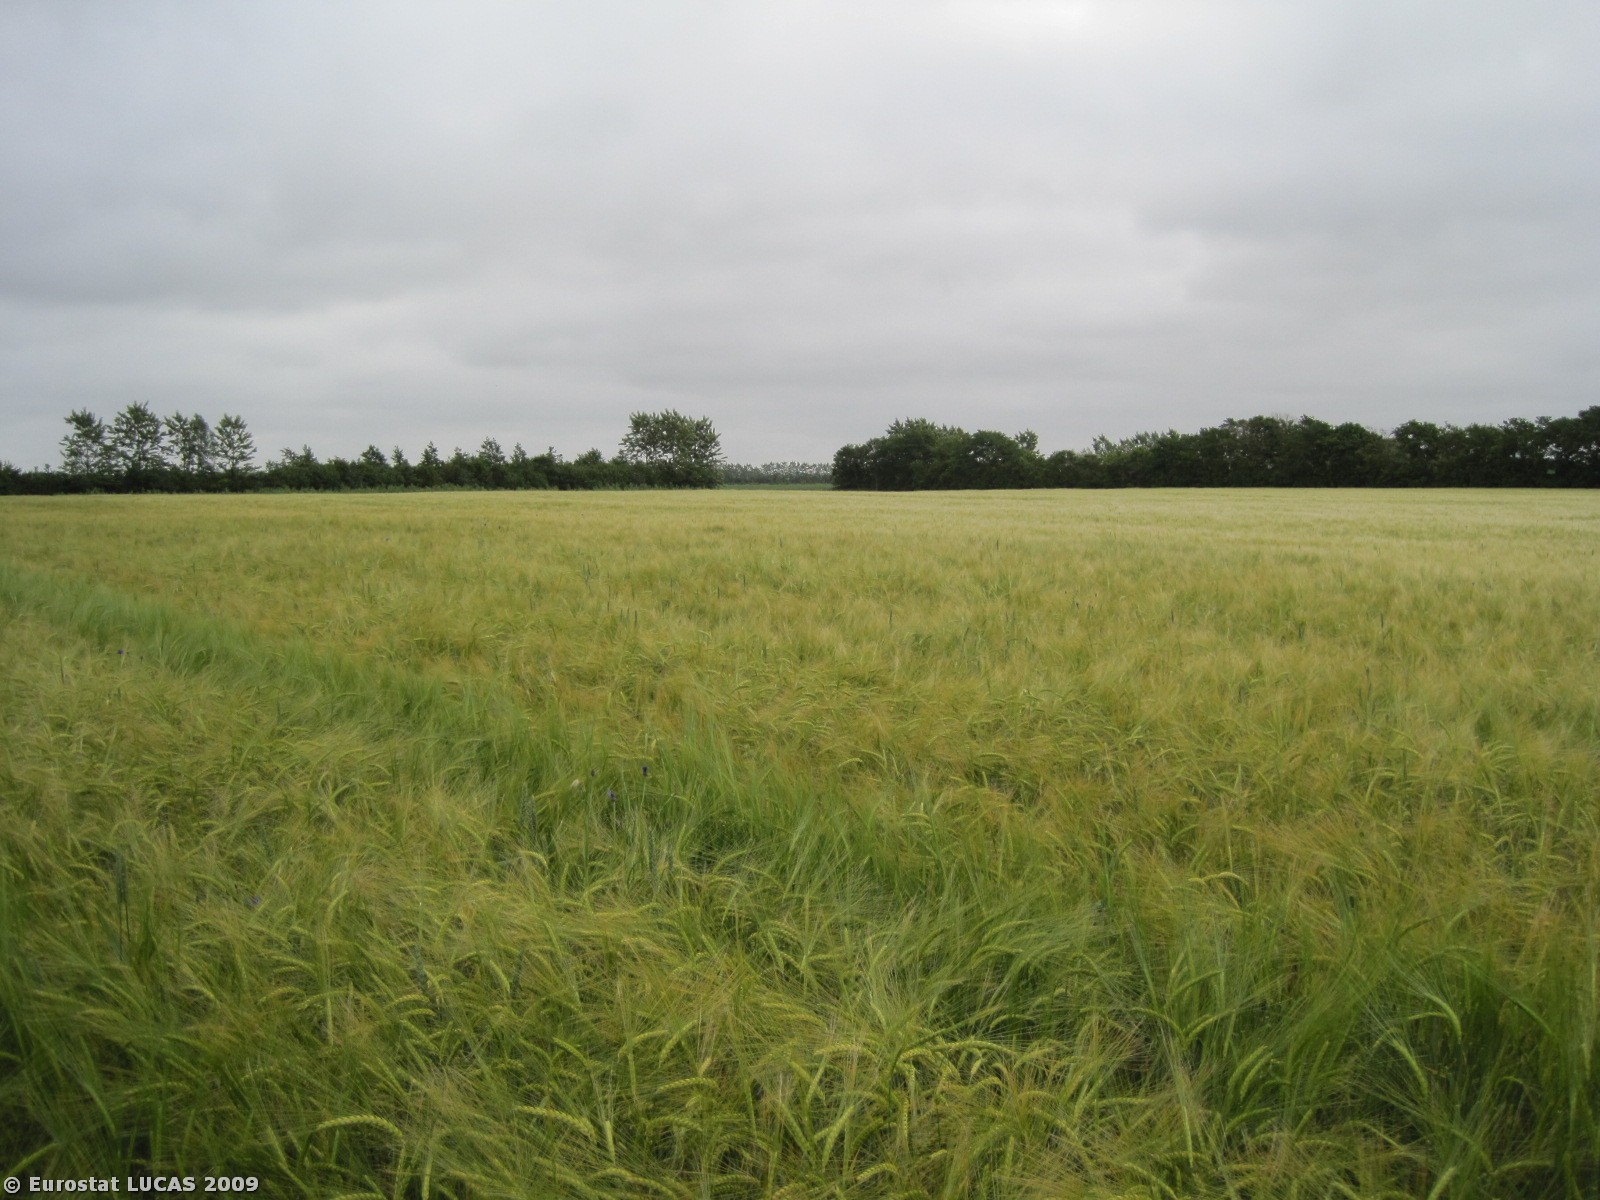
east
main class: Cropland
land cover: Barley
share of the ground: > 75 %
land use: Agriculture (excluding fallow land and kitchen gardens)
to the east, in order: Barley; Broadleaved woodland; Rape and turnip rape
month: June
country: DK
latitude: 57.2124
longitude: 9.9835
